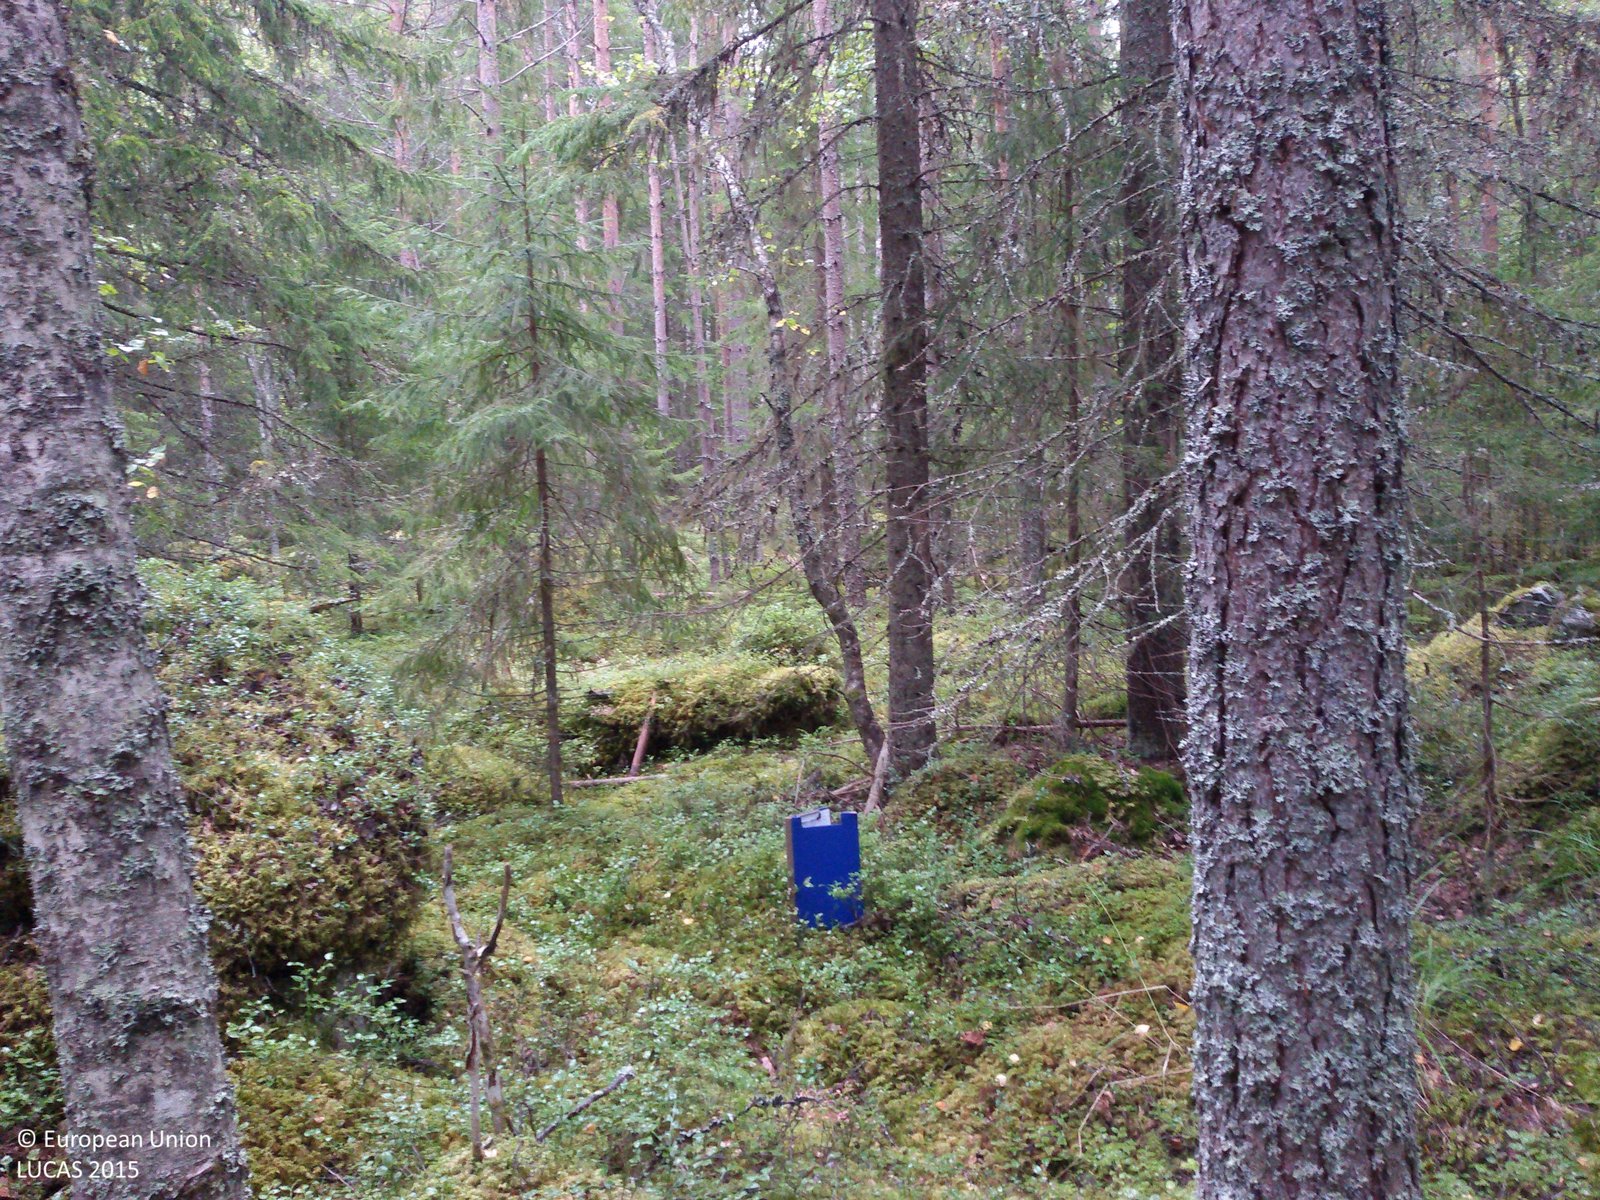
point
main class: Woodland
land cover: Spruce dominated coniferous woodland
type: boreal forest
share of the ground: > 75 %
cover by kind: coniferous forest trees 75 %, lichens and mosses 15 %, shrubs 10 %
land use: Forestry
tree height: > 5 m
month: September
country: SE
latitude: 60.7839
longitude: 15.3313
